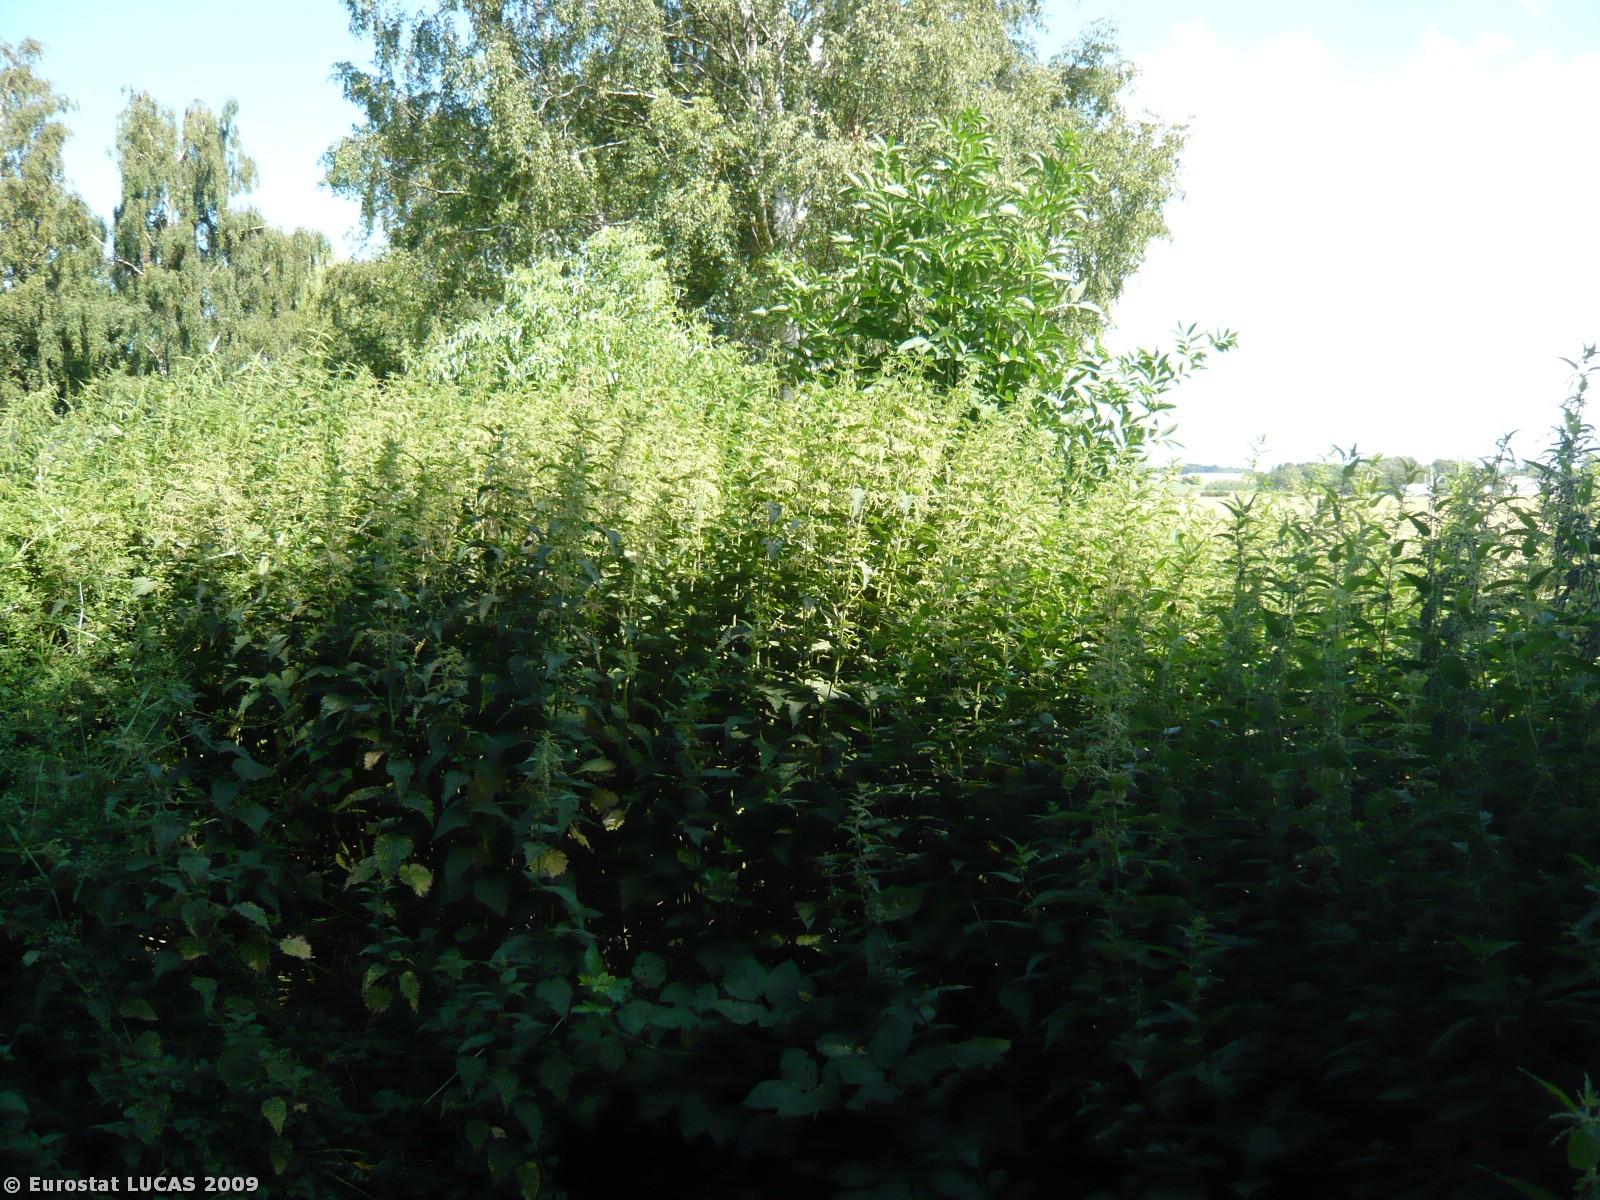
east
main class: Grassland
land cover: Grassland without tree/shrub cover
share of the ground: > 75 %
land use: Agriculture (excluding fallow land and kitchen gardens)
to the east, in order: Grassland without tree/shrub cover; Broadleaved woodland; Artificial constructions in urban areas
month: July
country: DK
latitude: 55.7809
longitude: 11.7044
